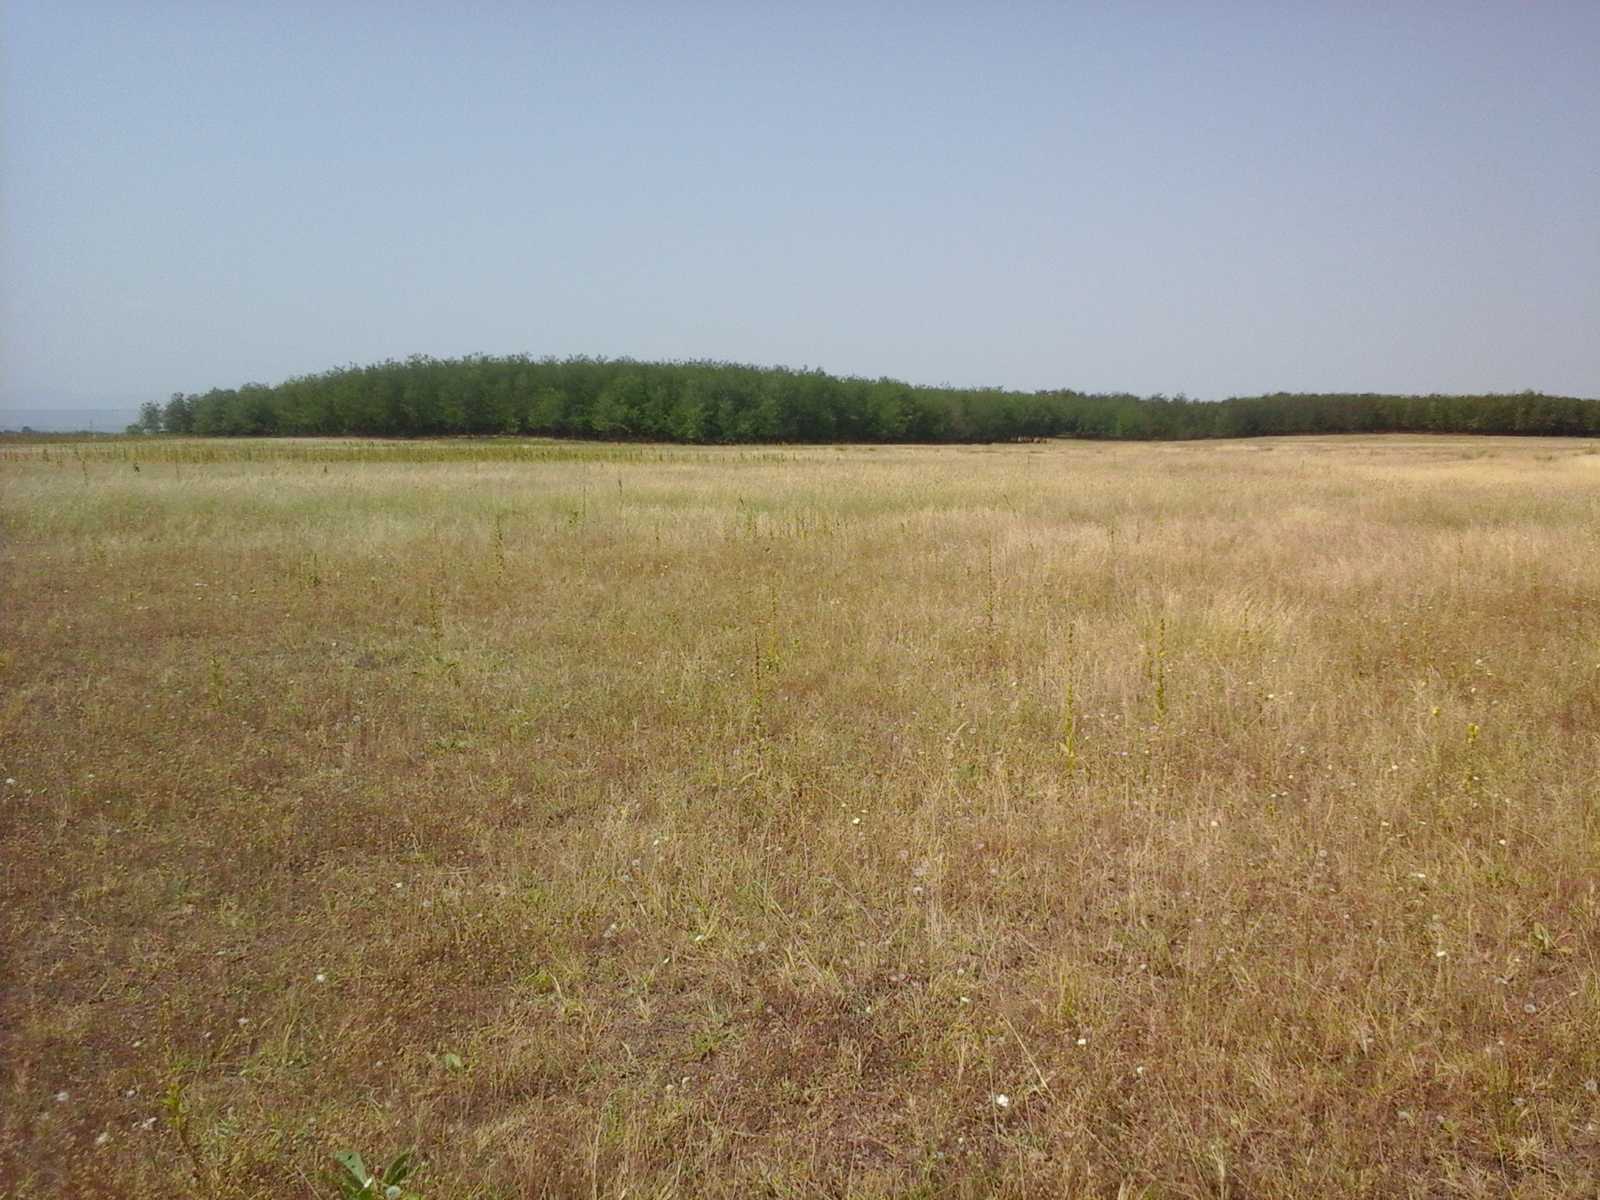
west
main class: Grassland
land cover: Grassland without tree/shrub cover
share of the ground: > 75 %
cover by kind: herbaceous plants 100 %
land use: Agriculture (excluding fallow land and kitchen gardens)
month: August
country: RO
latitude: 44.3959
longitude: 22.6317
